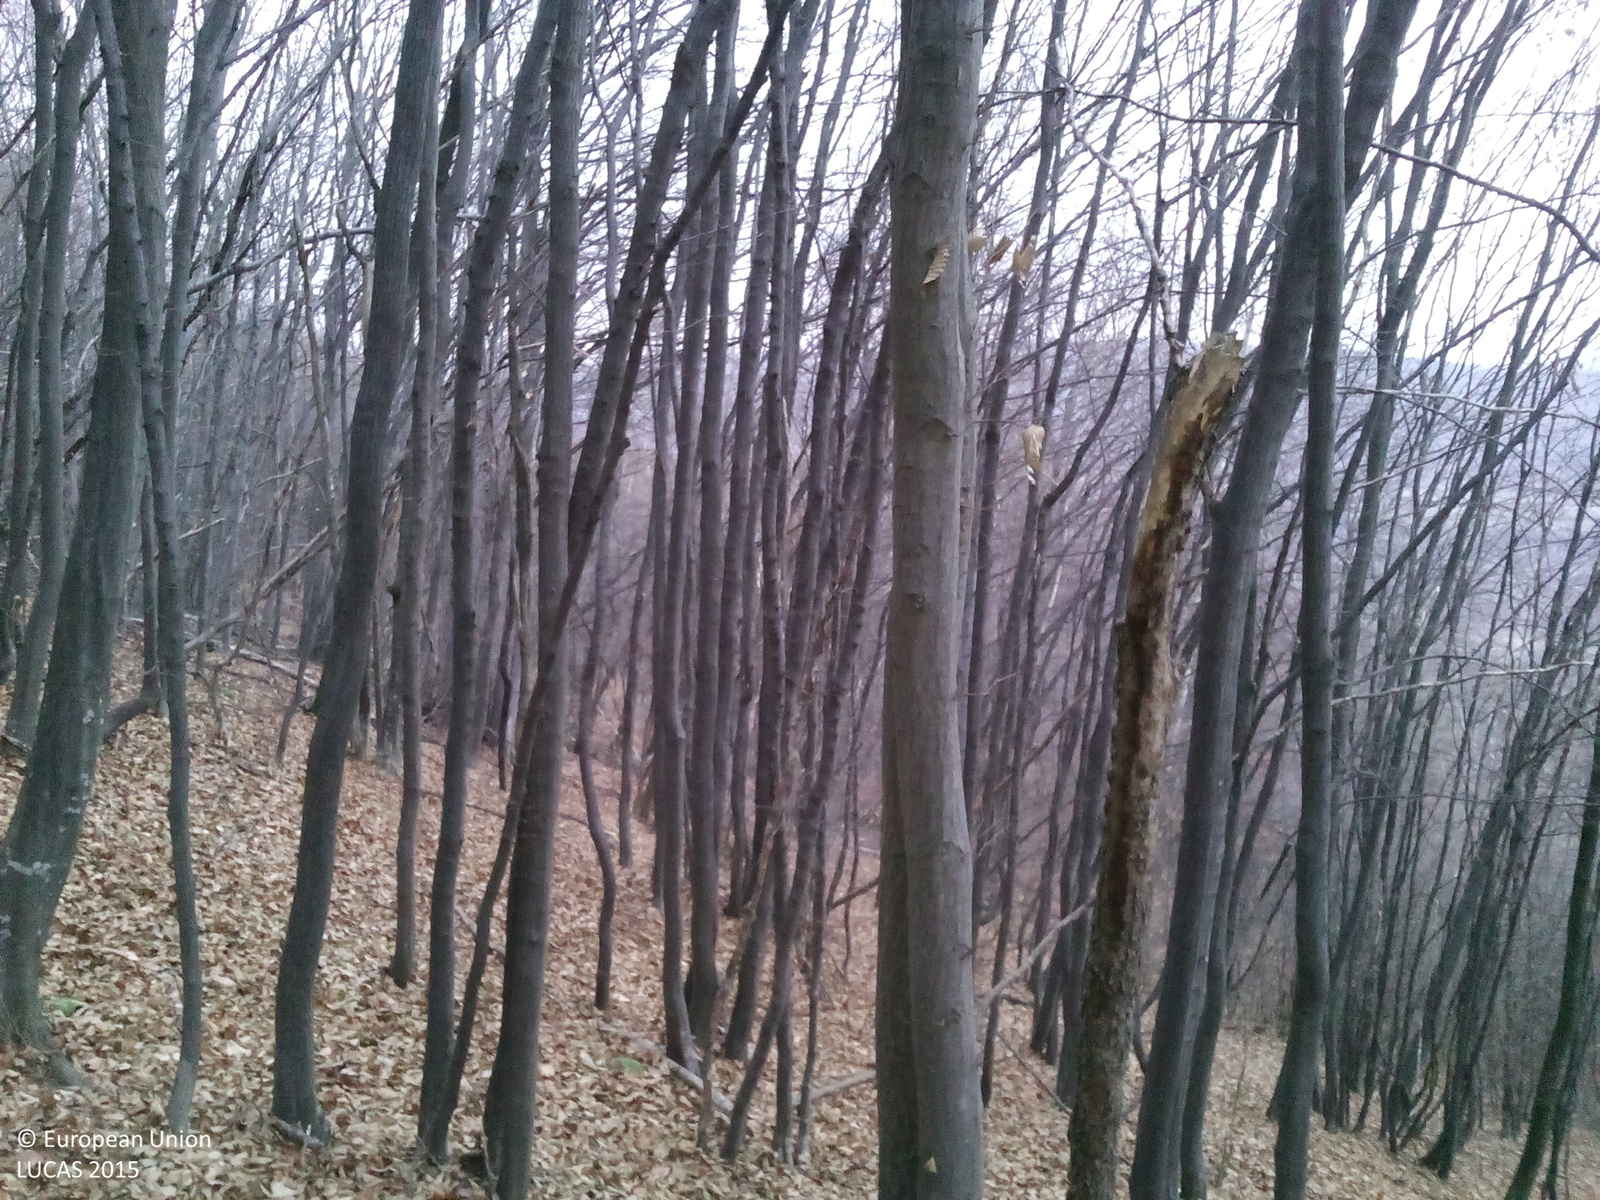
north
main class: Woodland
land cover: Broadleaved woodland
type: mountainous beech forest
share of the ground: > 75 %
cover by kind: broadleaved forest trees 80 %, unconsolidated bare surface 20 %
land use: Forestry
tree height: > 5 m
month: December
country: BG
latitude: 42.8021
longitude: 22.8307
